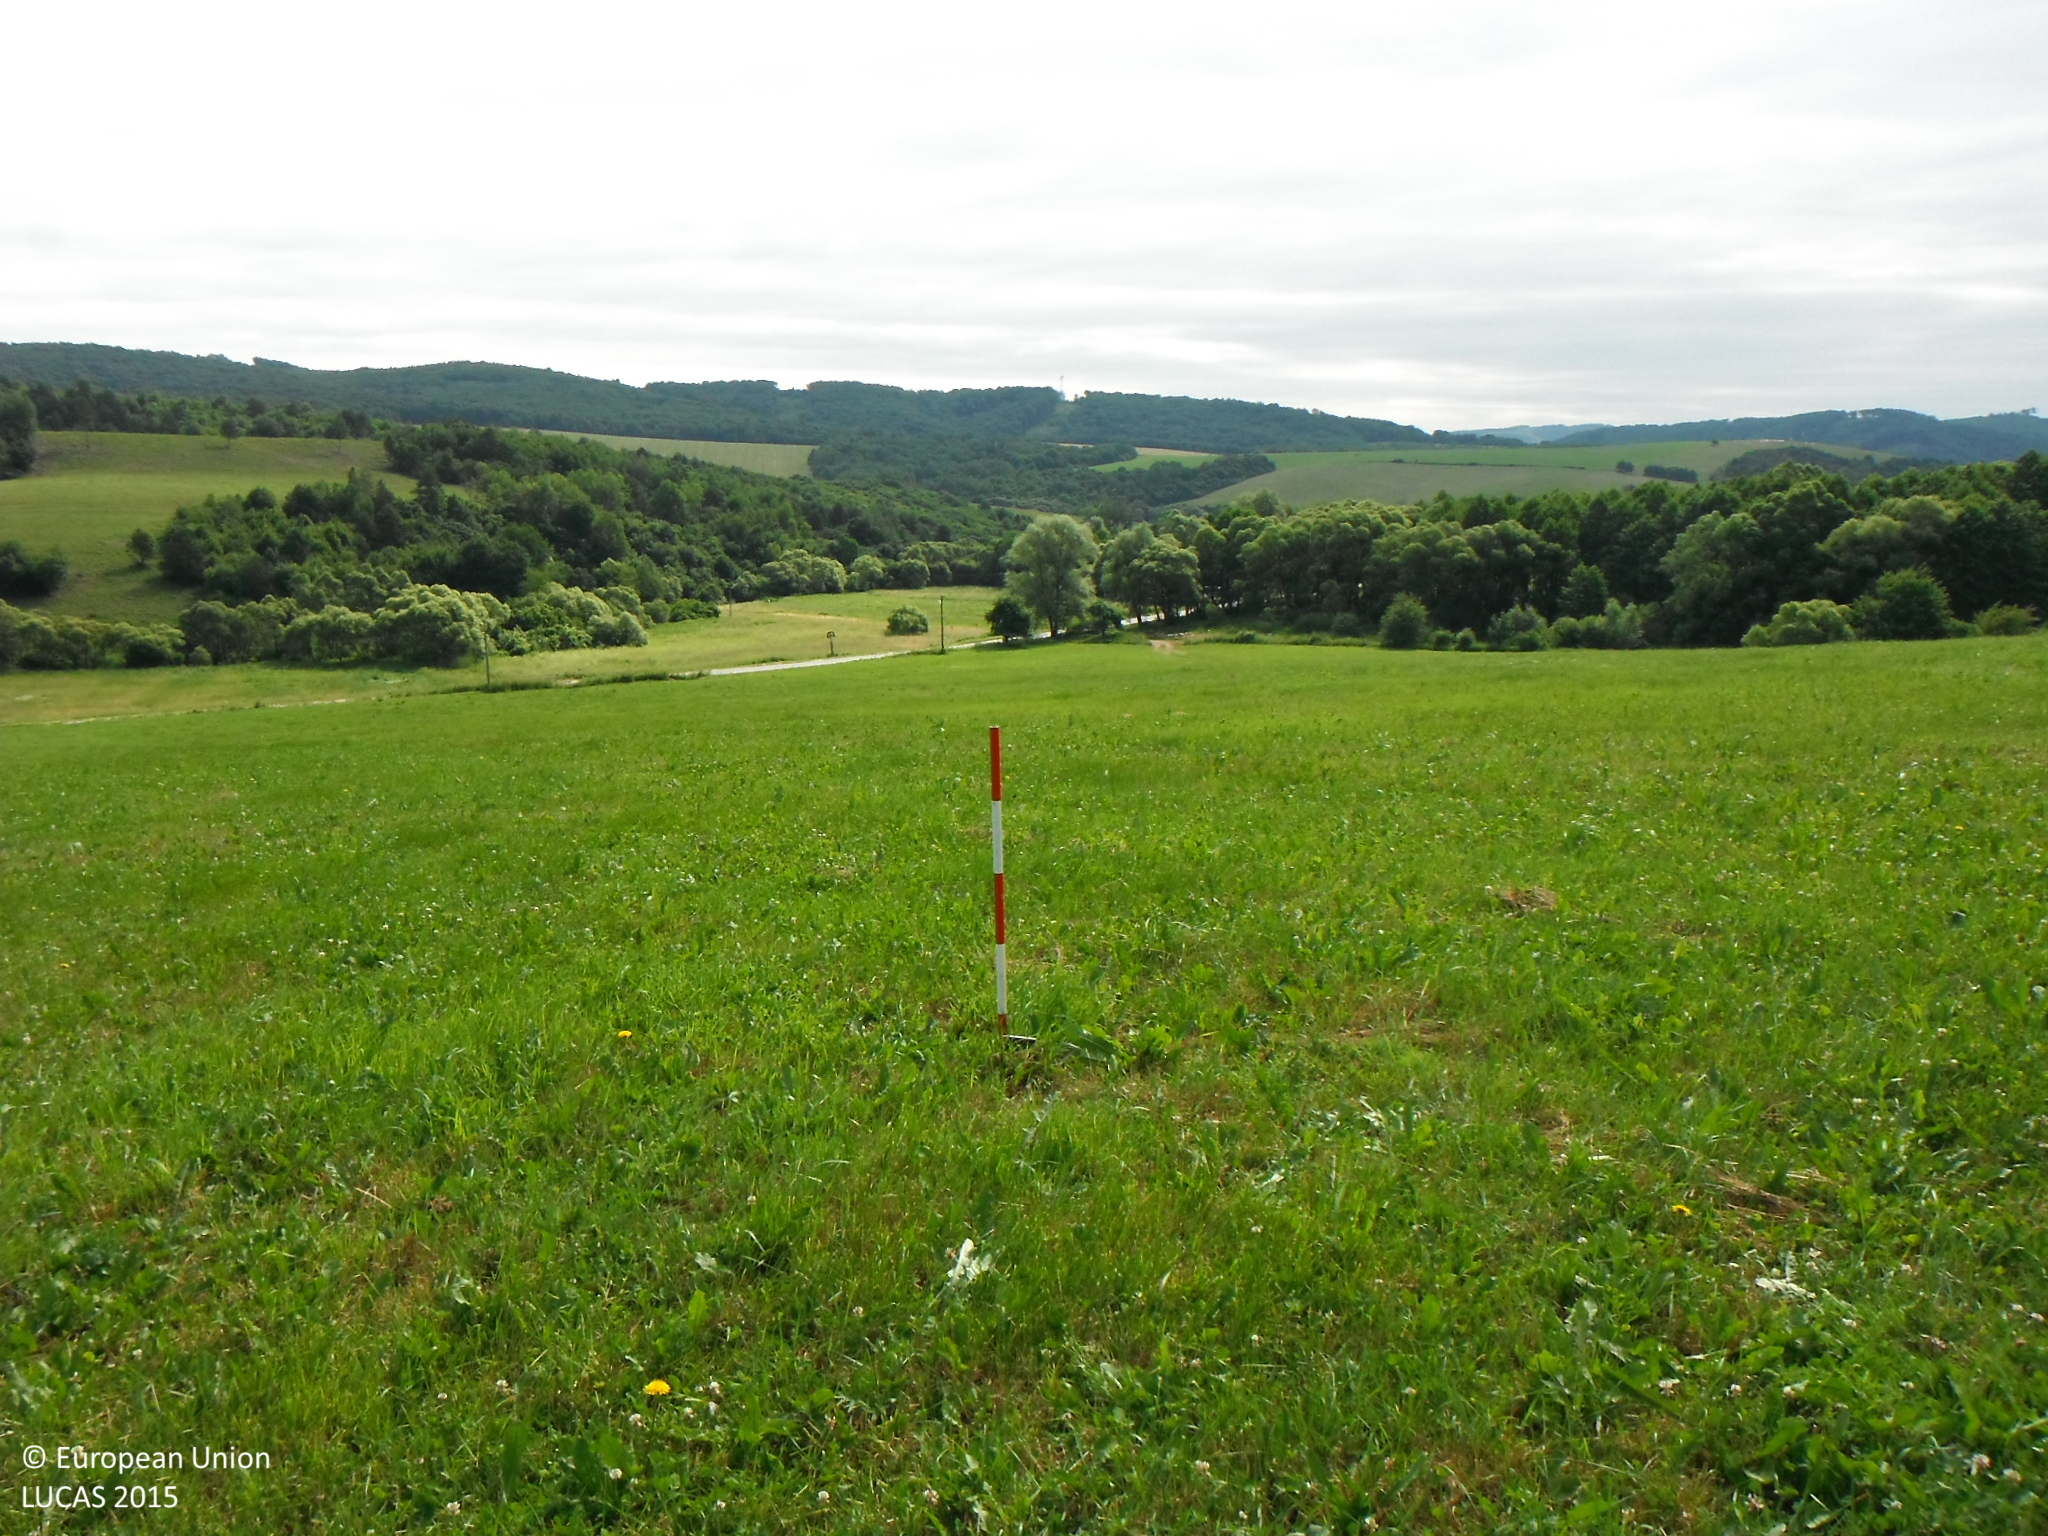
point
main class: Grassland
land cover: Grassland without tree/shrub cover
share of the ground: > 75 %
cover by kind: herbaceous plants 100 %
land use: Agriculture (excluding fallow land and kitchen gardens)
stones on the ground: < 10 %
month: June
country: SK
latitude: 49.1528
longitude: 21.6086
